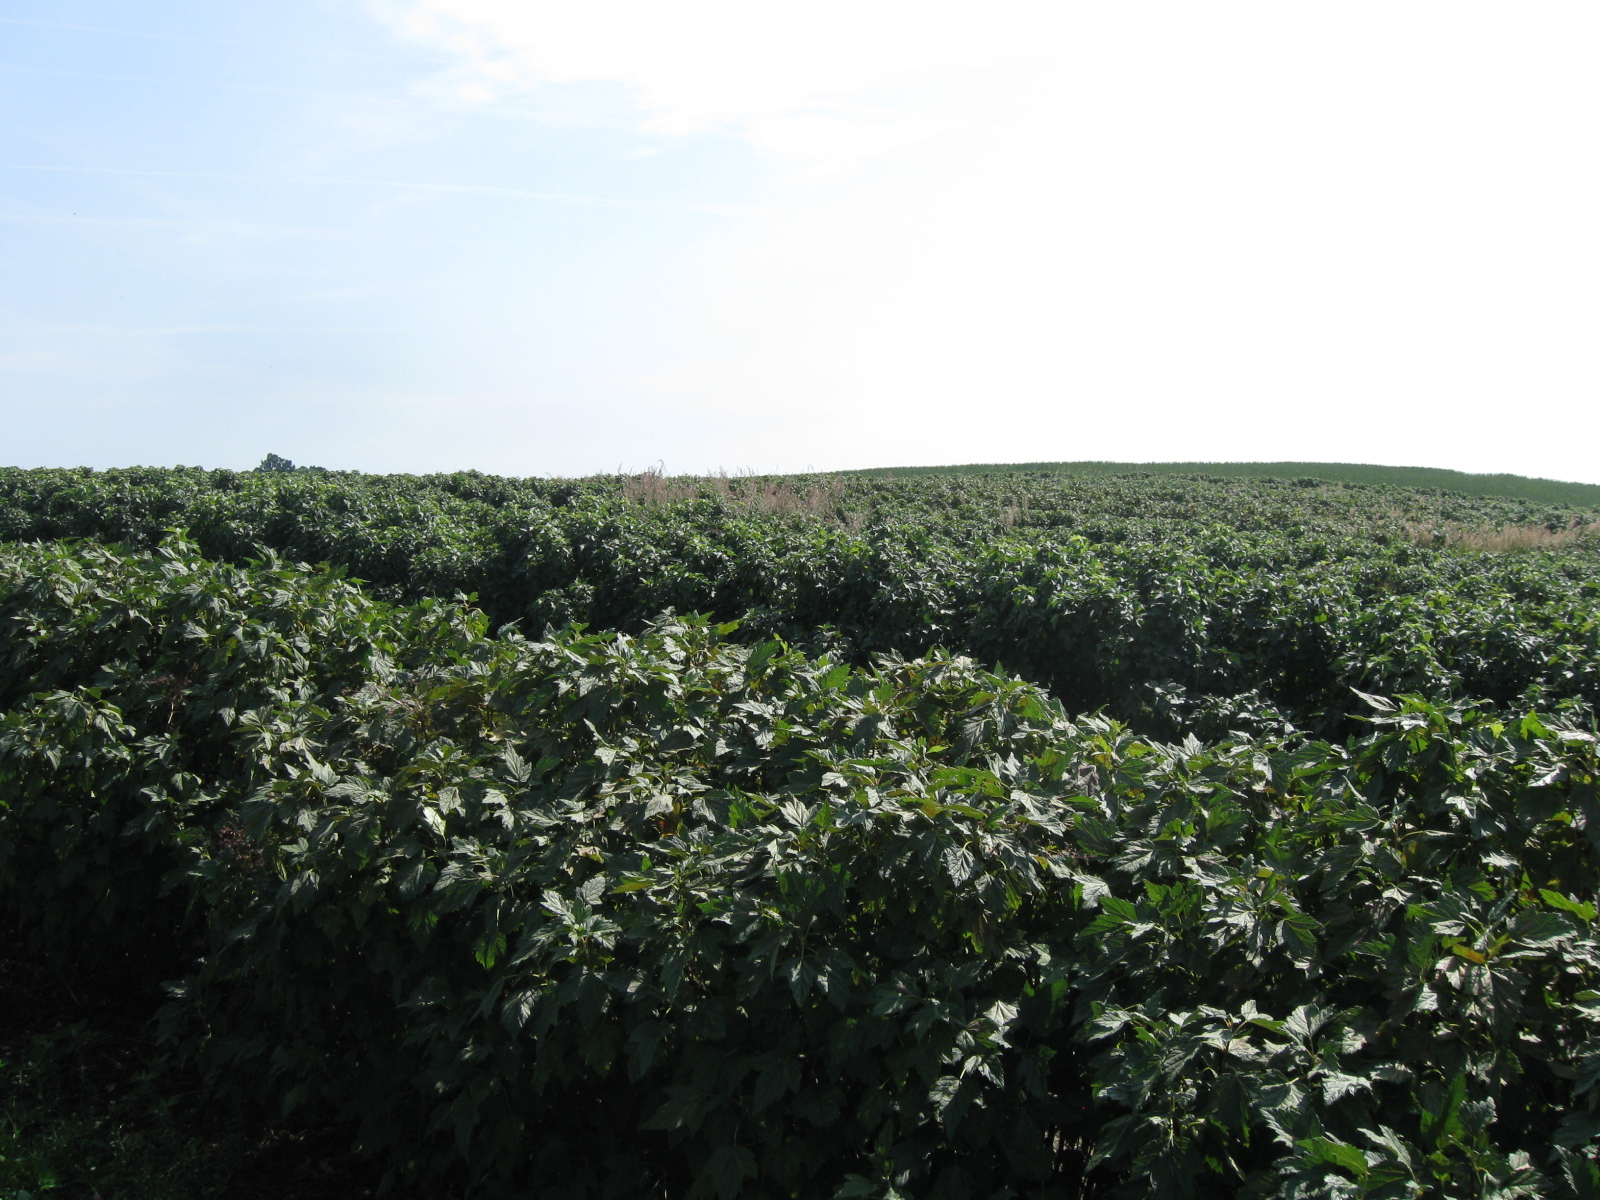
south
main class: Cropland
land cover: Other fruit trees and berries
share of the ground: 50 - 75 %
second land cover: Spontaneously vegetated surfaces
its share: 50 - 75 %
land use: Agriculture (excluding fallow land and kitchen gardens)
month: July
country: LT
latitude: 54.6937
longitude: 23.9136
